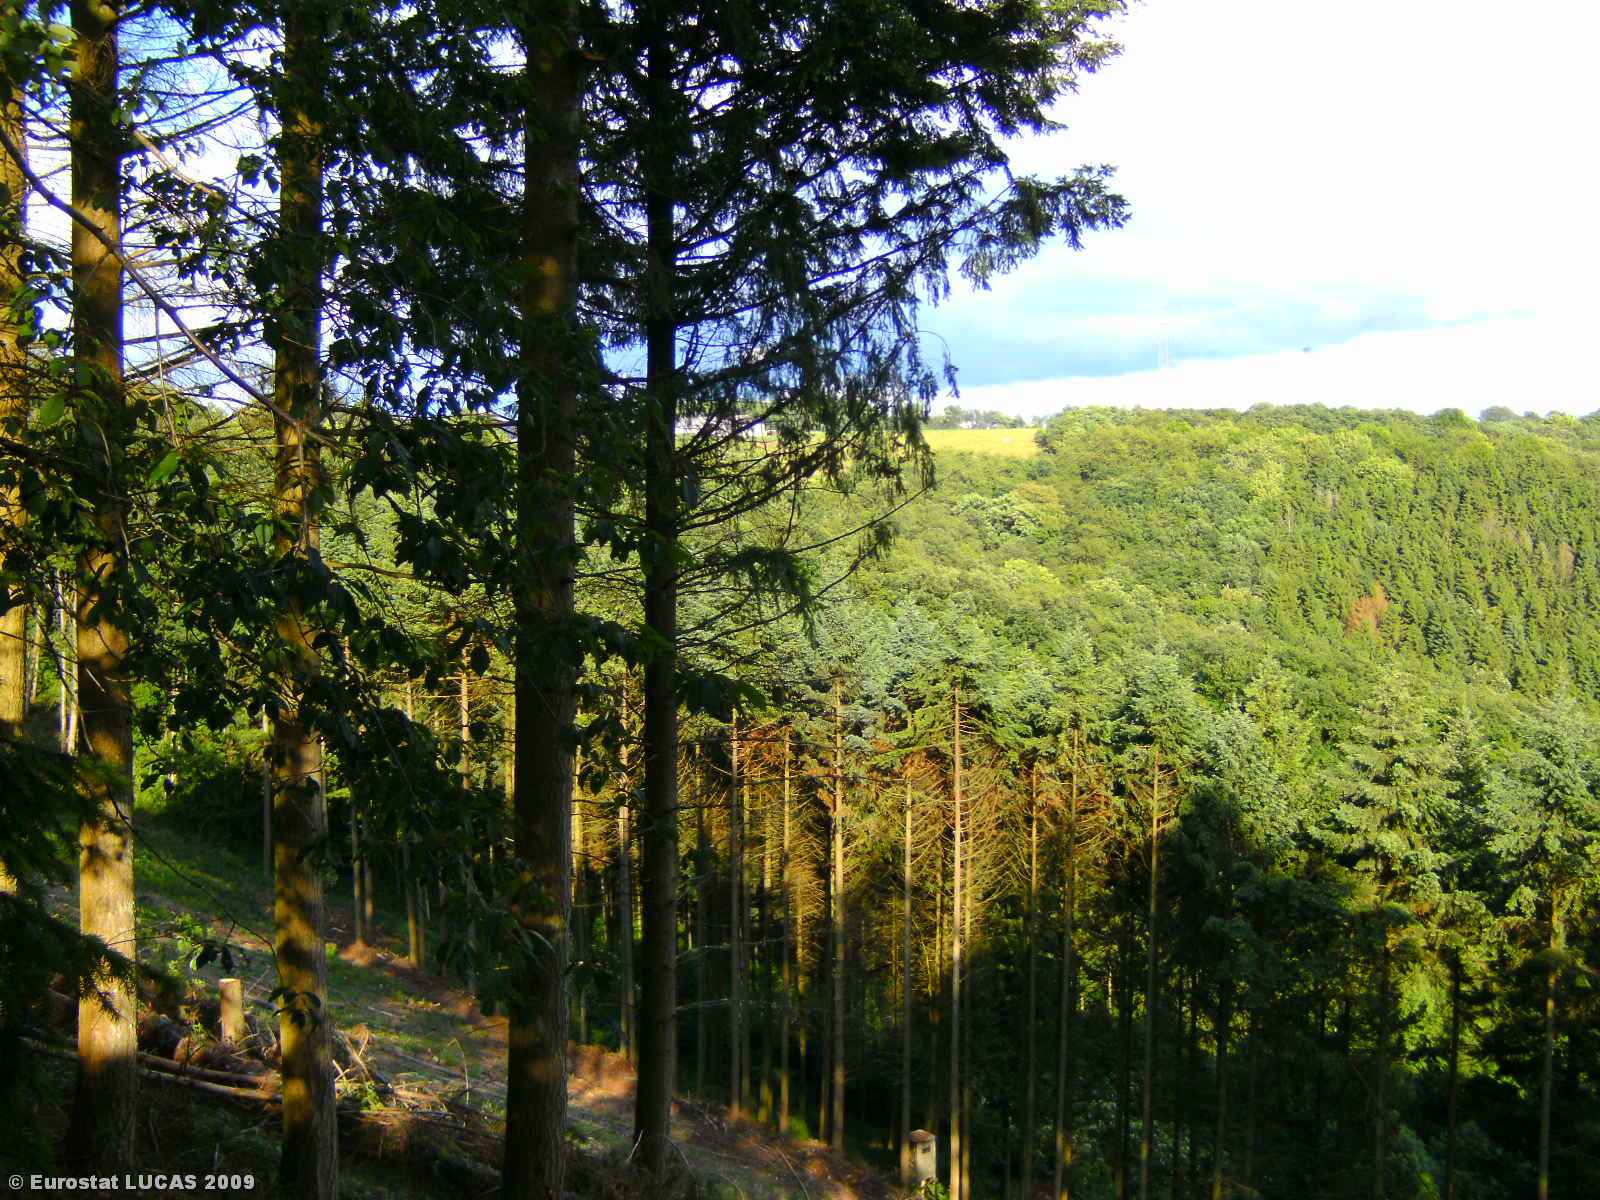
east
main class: Woodland
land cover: Coniferous woodland
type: hemiboreal forest and nemoral coniferous forest and mixed broadleaved-coniferous forest
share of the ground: > 75 %
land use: Forestry
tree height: > 5 m
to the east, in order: Coniferous woodland; Tracks; Bare land; Spontaneously vegetated surfaces; Tracks; Bare land; Grassland without tree/shrub cover; Coniferous woodland; Broadleaved woodland; Shrubland with sparse tree cover
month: June
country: LU
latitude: 49.9020
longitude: 6.1149
